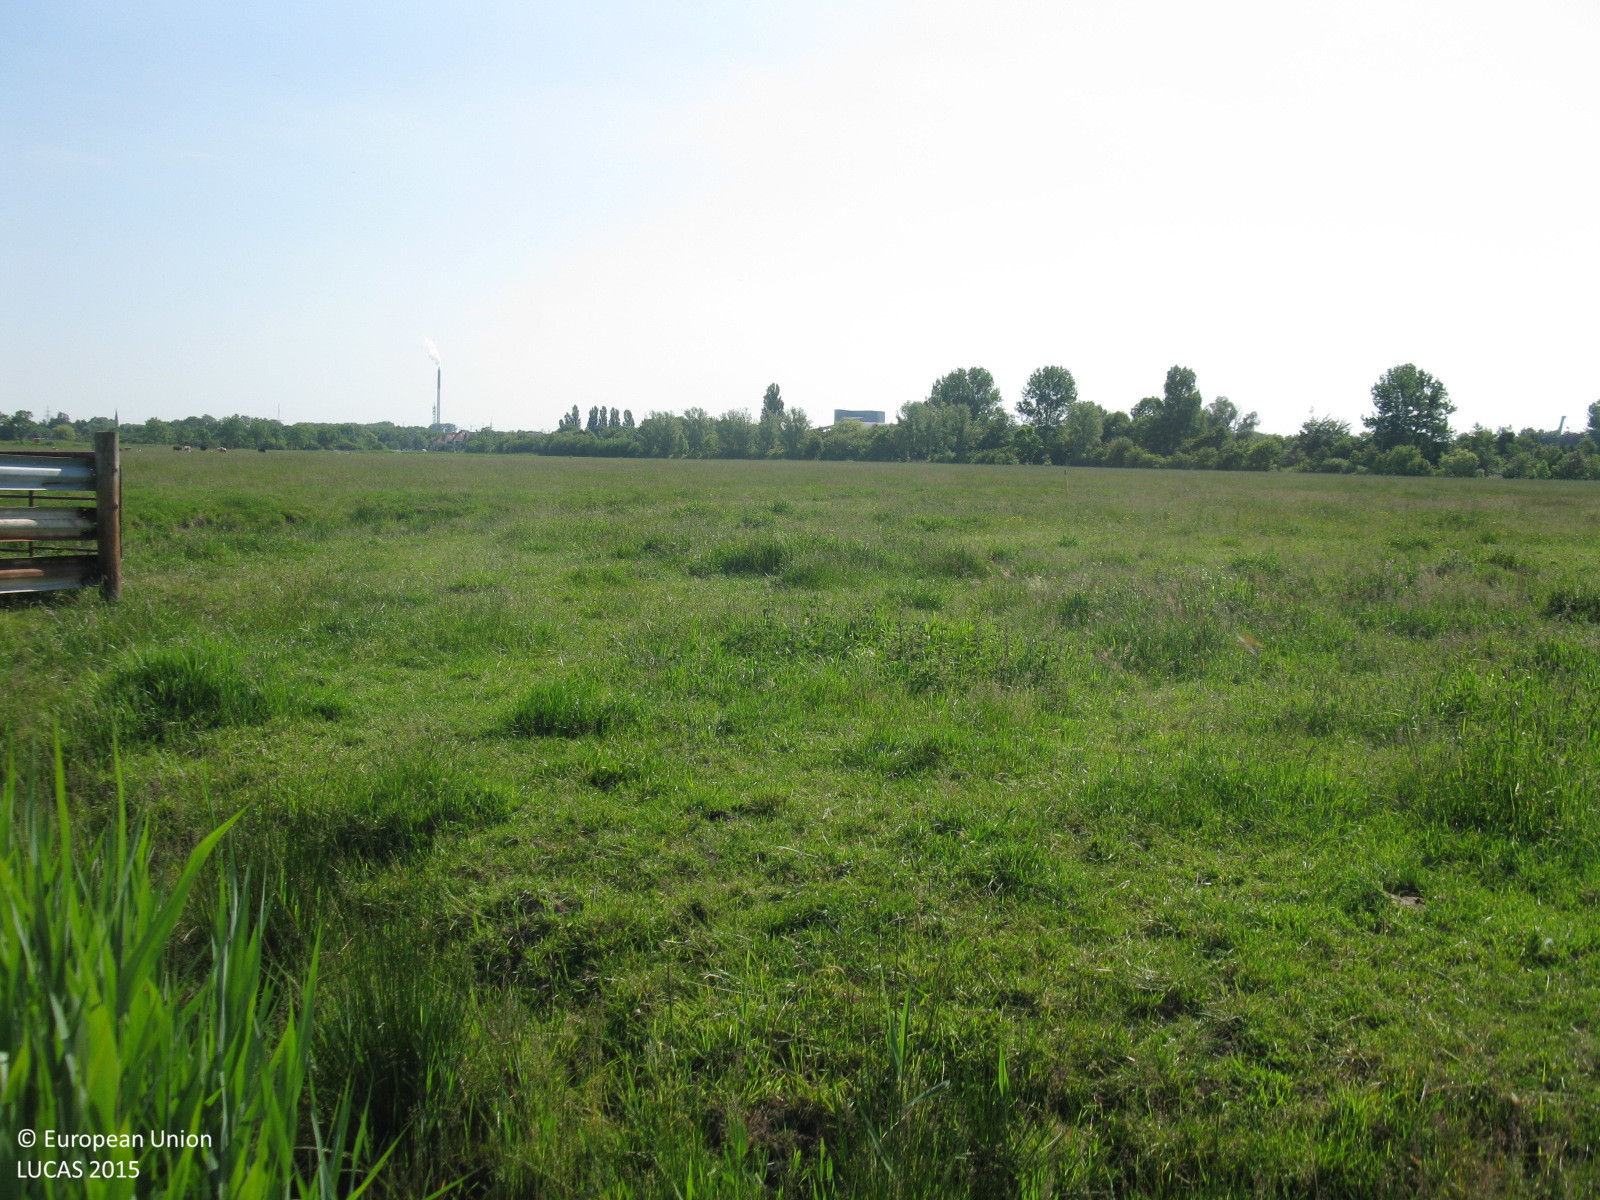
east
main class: Grassland
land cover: Grassland without tree/shrub cover
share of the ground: > 75 %
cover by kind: herbaceous plants 100 %
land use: Agriculture (excluding fallow land and kitchen gardens)
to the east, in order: Grassland without tree/shrub cover; Inland fresh running water; Grassland without tree/shrub cover; Ditches and canals; Grassland without tree/shrub cover
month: June
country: DE
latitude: 53.5186
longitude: 8.5075
